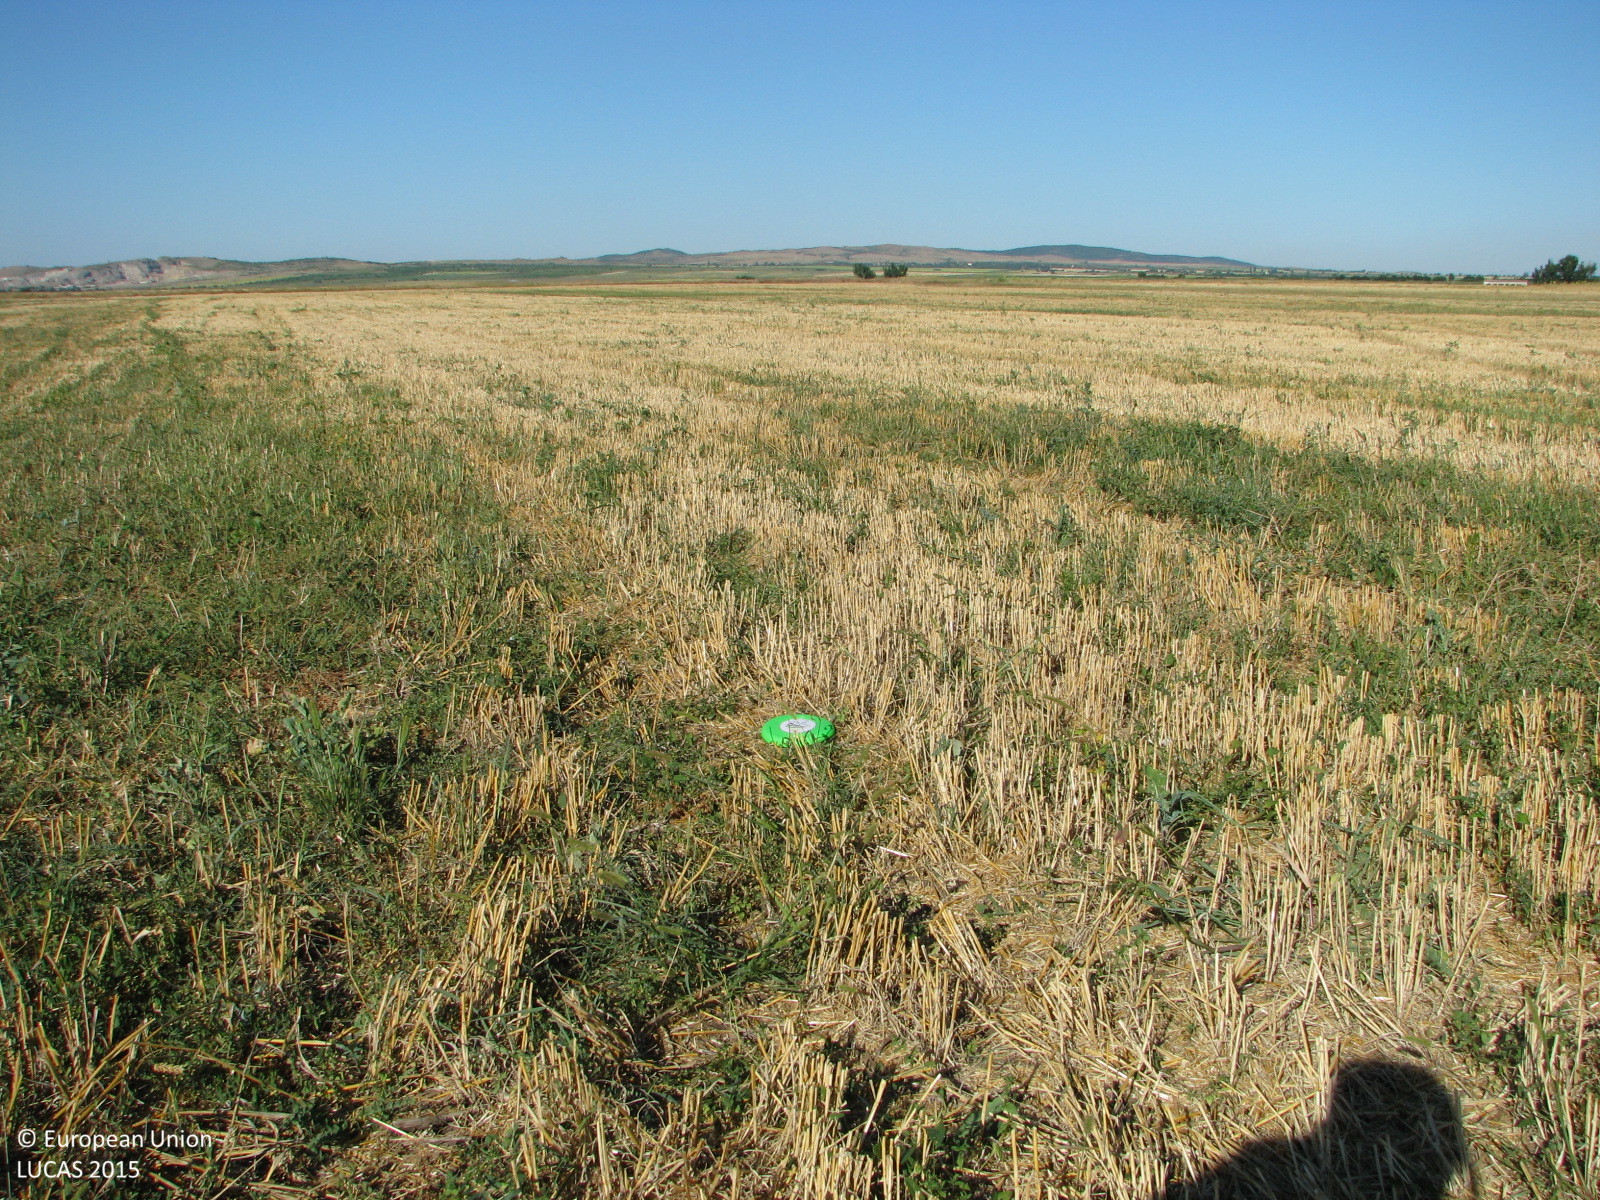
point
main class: Cropland
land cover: Common wheat
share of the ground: 10 - 25 %
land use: Agriculture (excluding fallow land and kitchen gardens)
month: July
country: BG
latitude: 42.4040
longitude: 25.9836
